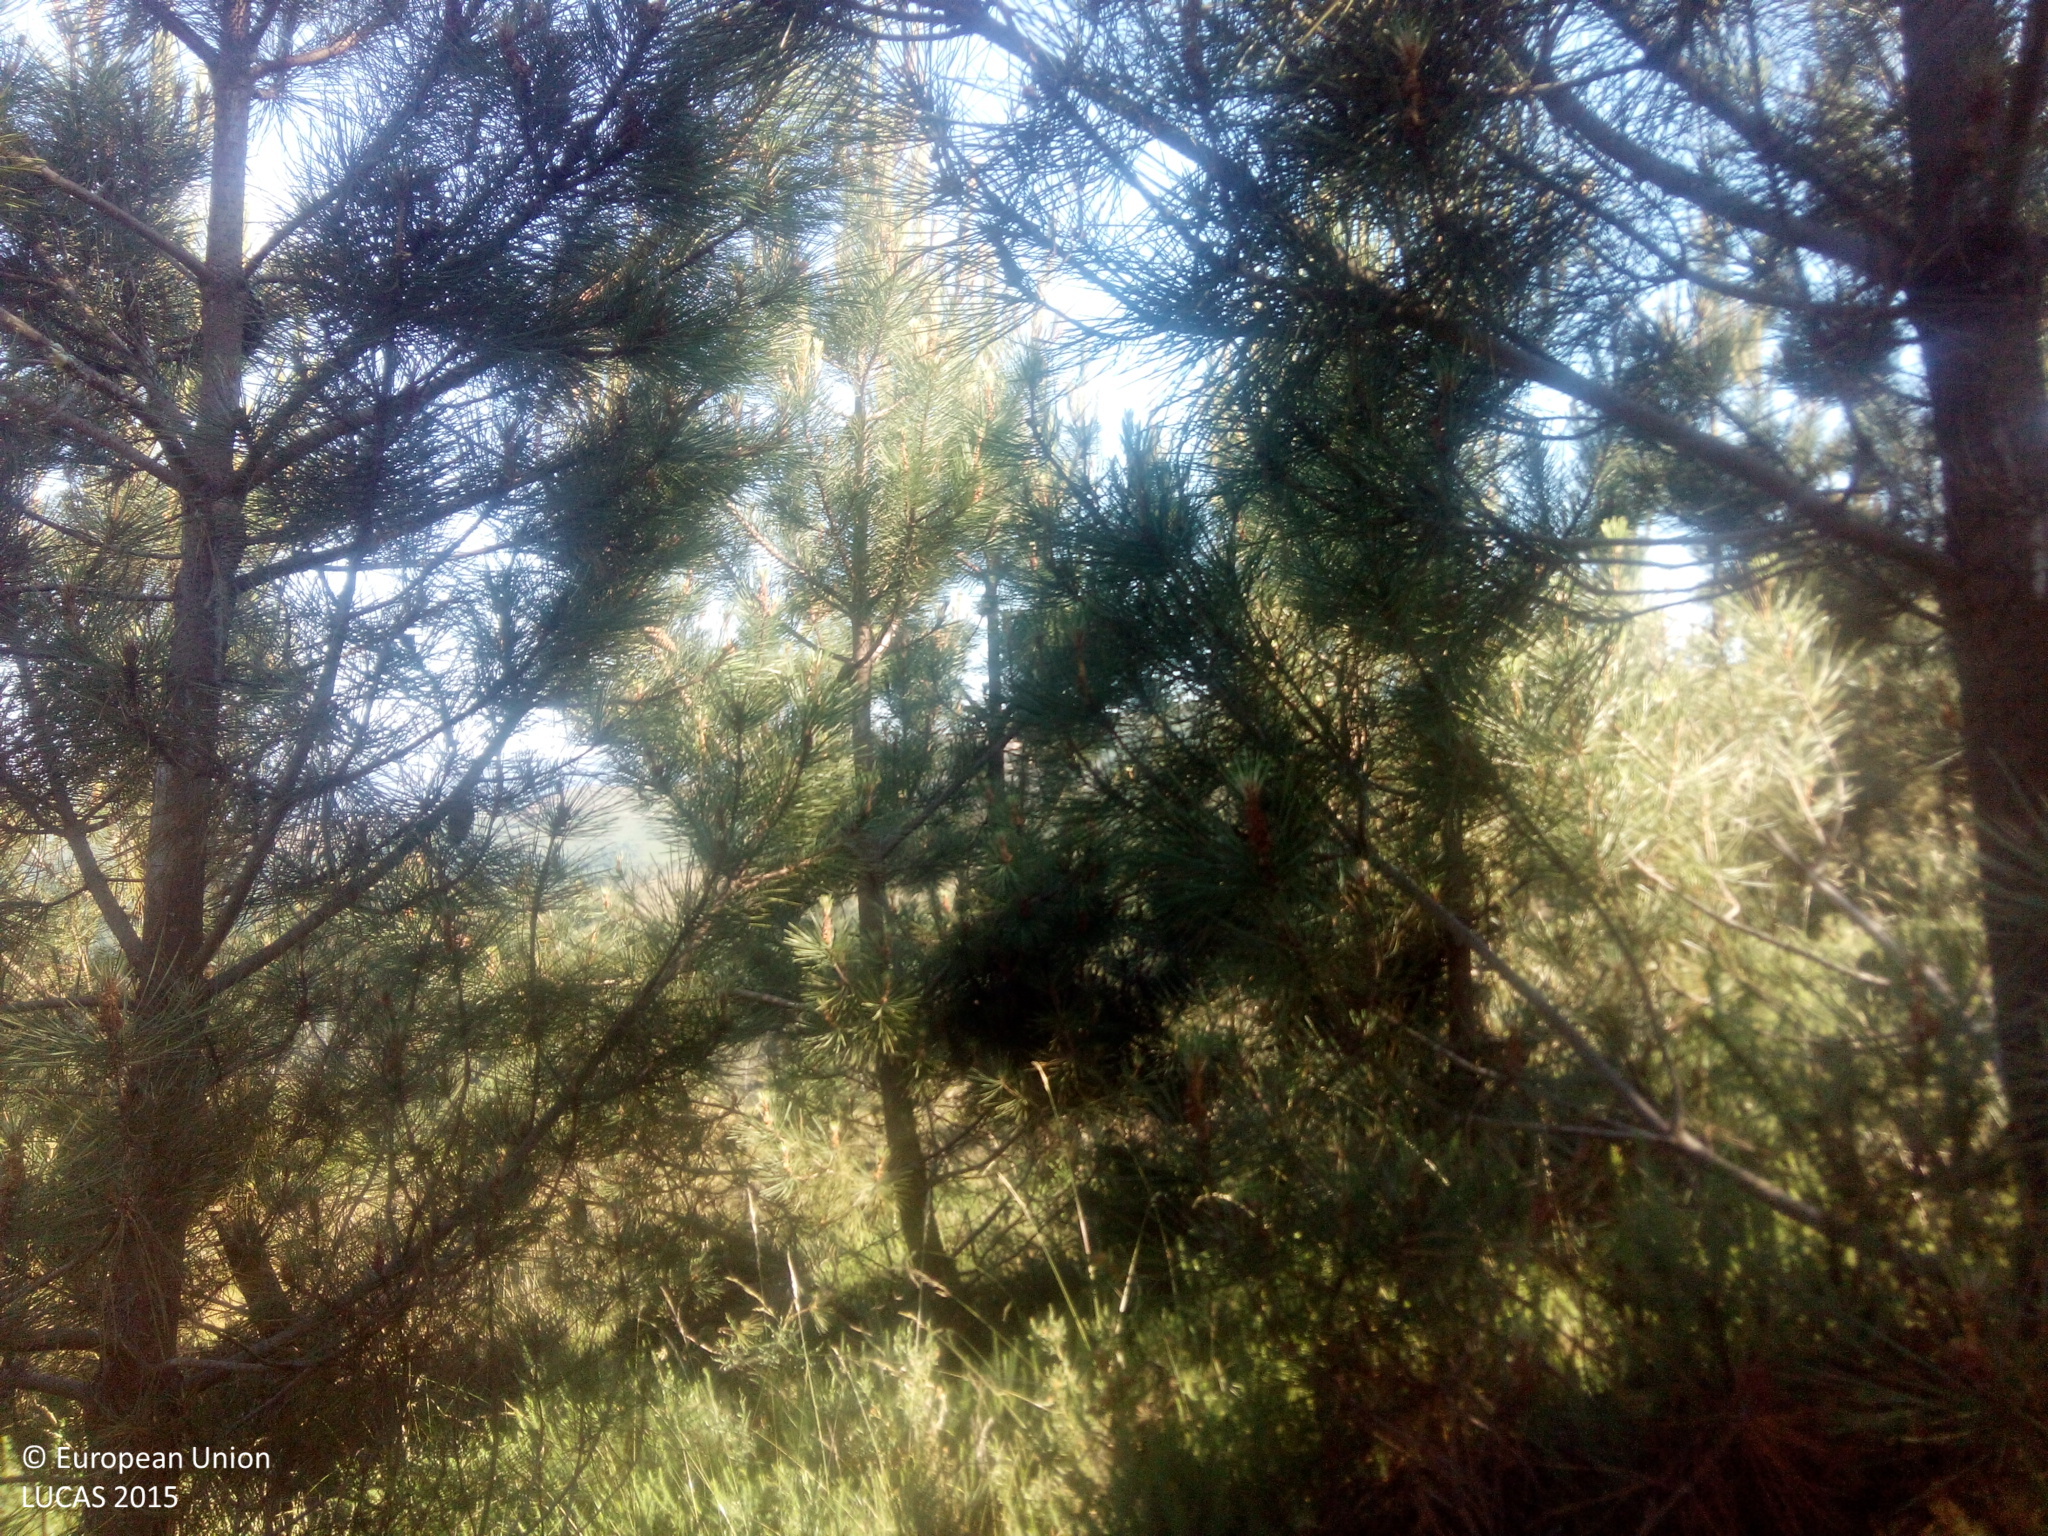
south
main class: Woodland
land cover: Pine dominated coniferous woodland
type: hemiboreal forest and nemoral coniferous forest and mixed broadleaved-coniferous forest
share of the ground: > 75 %
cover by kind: coniferous forest trees 100 %
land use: Forestry
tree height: < 5 m
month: June
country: ES
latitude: 42.4444
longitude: -8.3163
